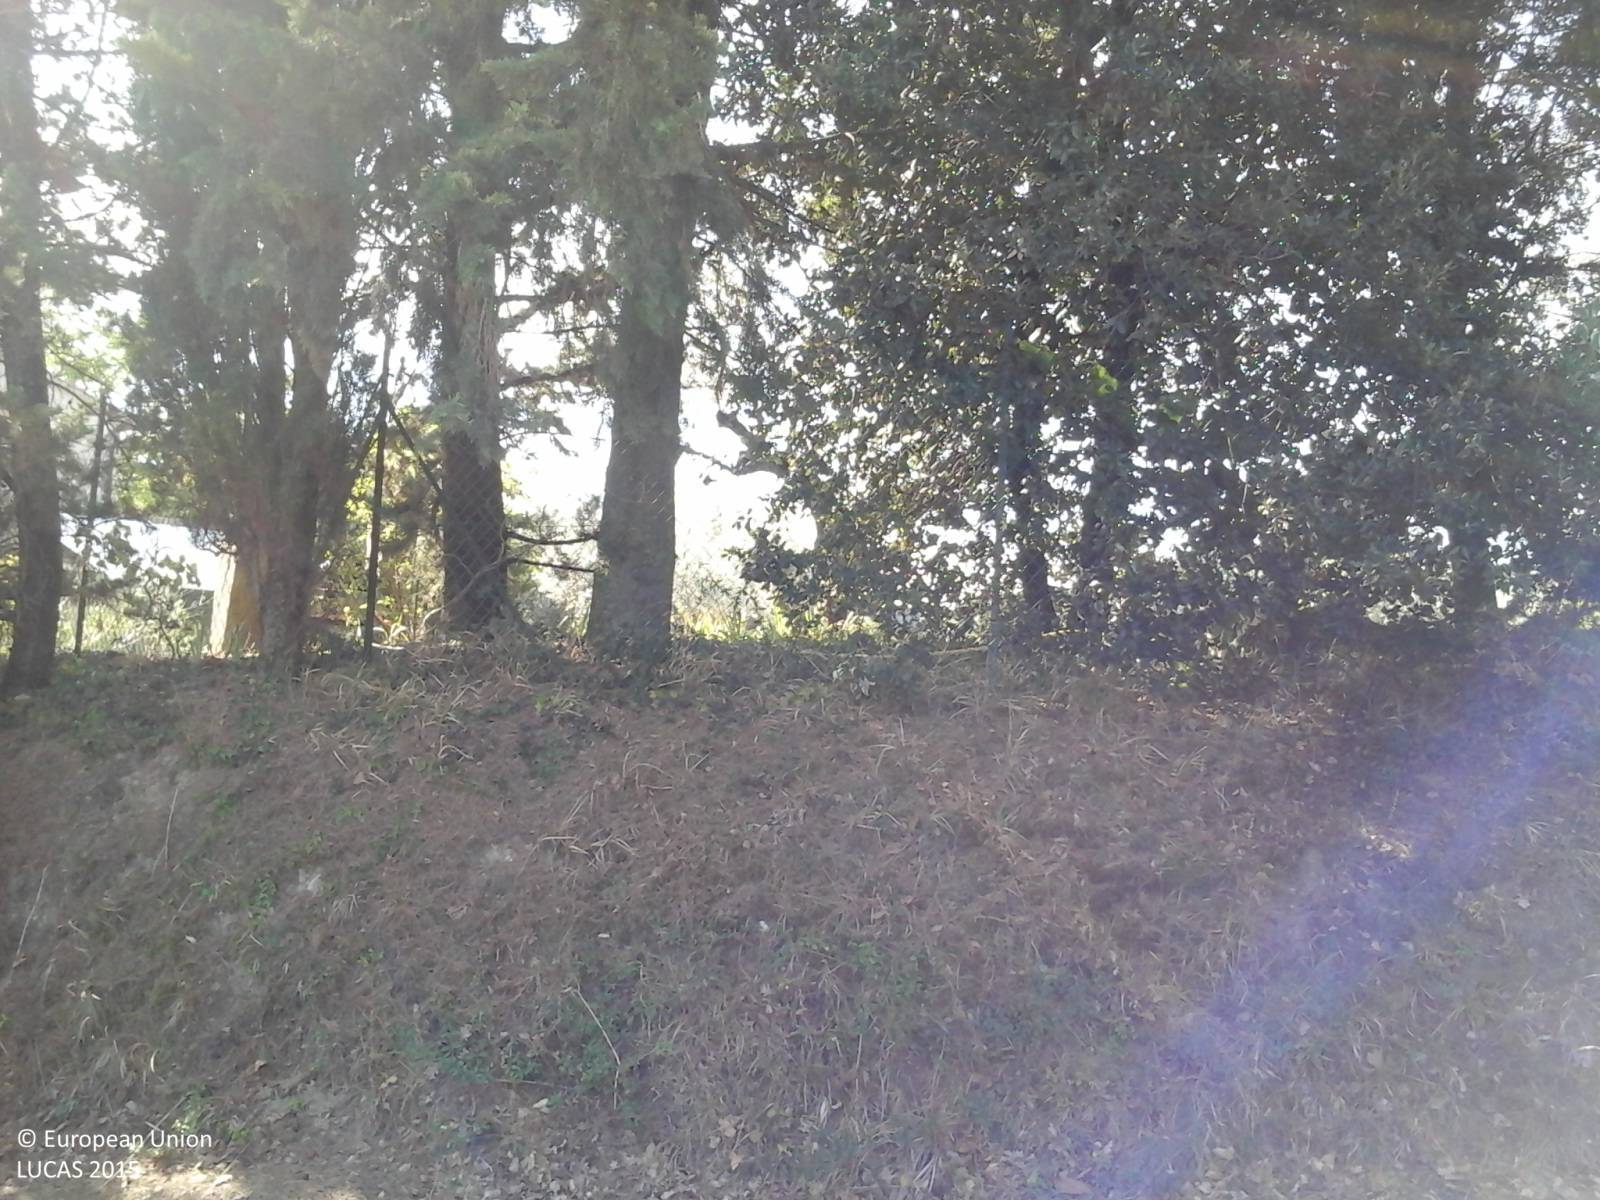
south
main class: Woodland
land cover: Other mixed woodland
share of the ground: > 75 %
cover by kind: coniferous forest trees 60 %, broadleaved forest trees 40 %
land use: Forestry
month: September
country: IT
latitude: 43.1311
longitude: 12.4147
